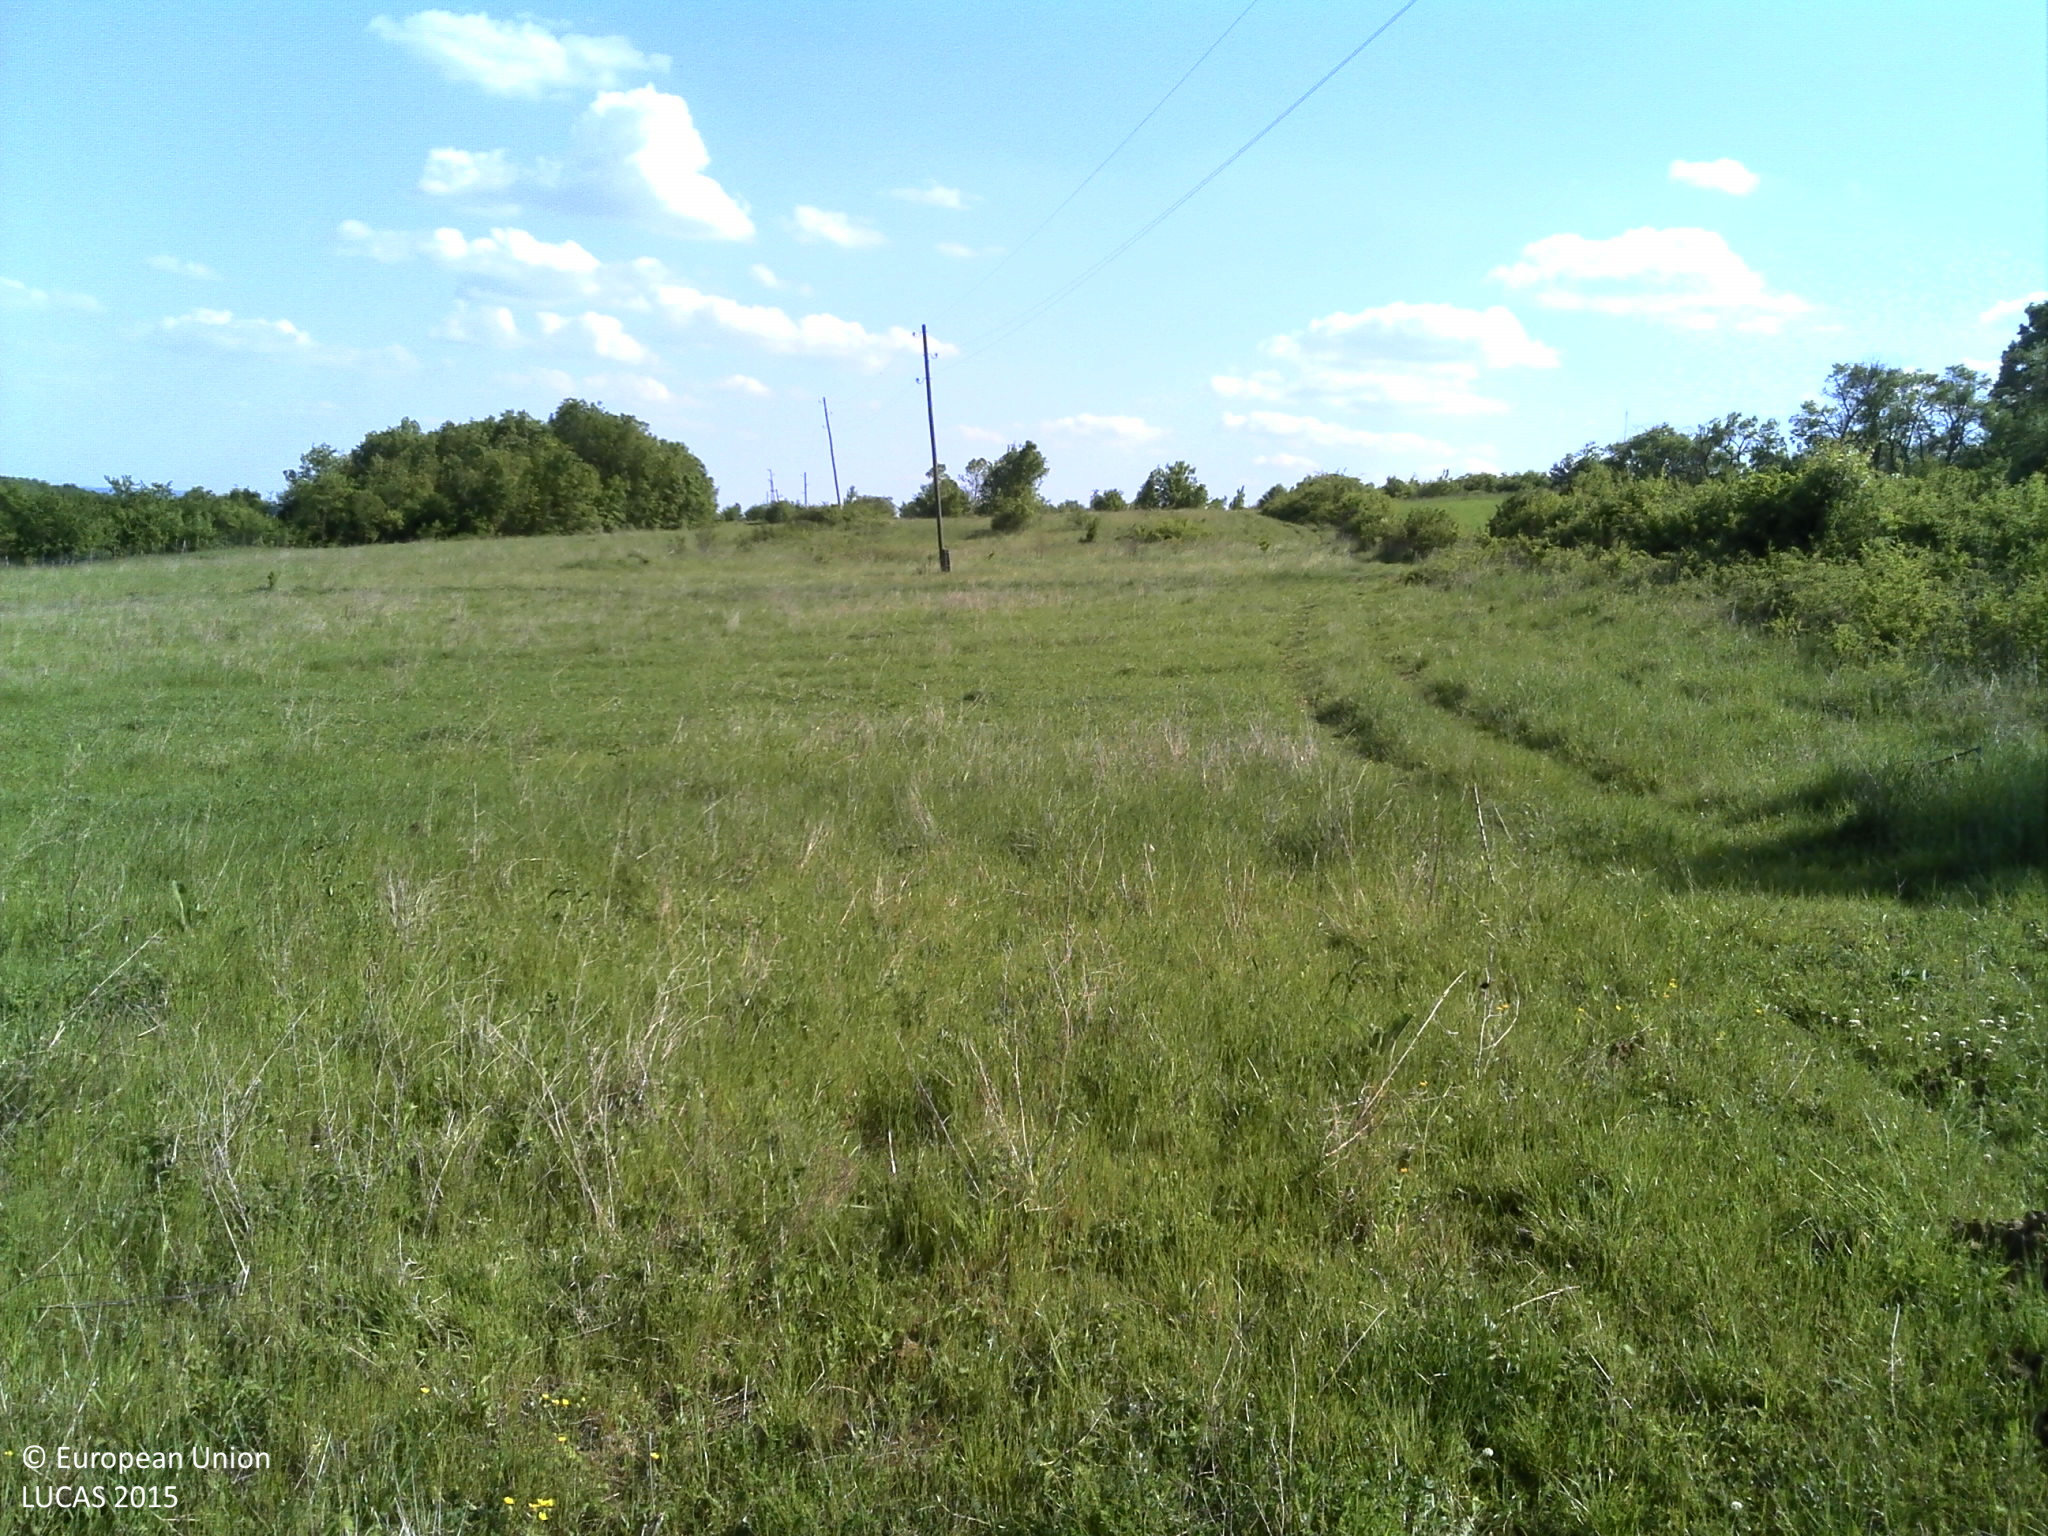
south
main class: Cropland
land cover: Clovers
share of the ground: > 75 %
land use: Agriculture (excluding fallow land and kitchen gardens)
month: May
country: HR
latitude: 45.2297
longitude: 18.0910
